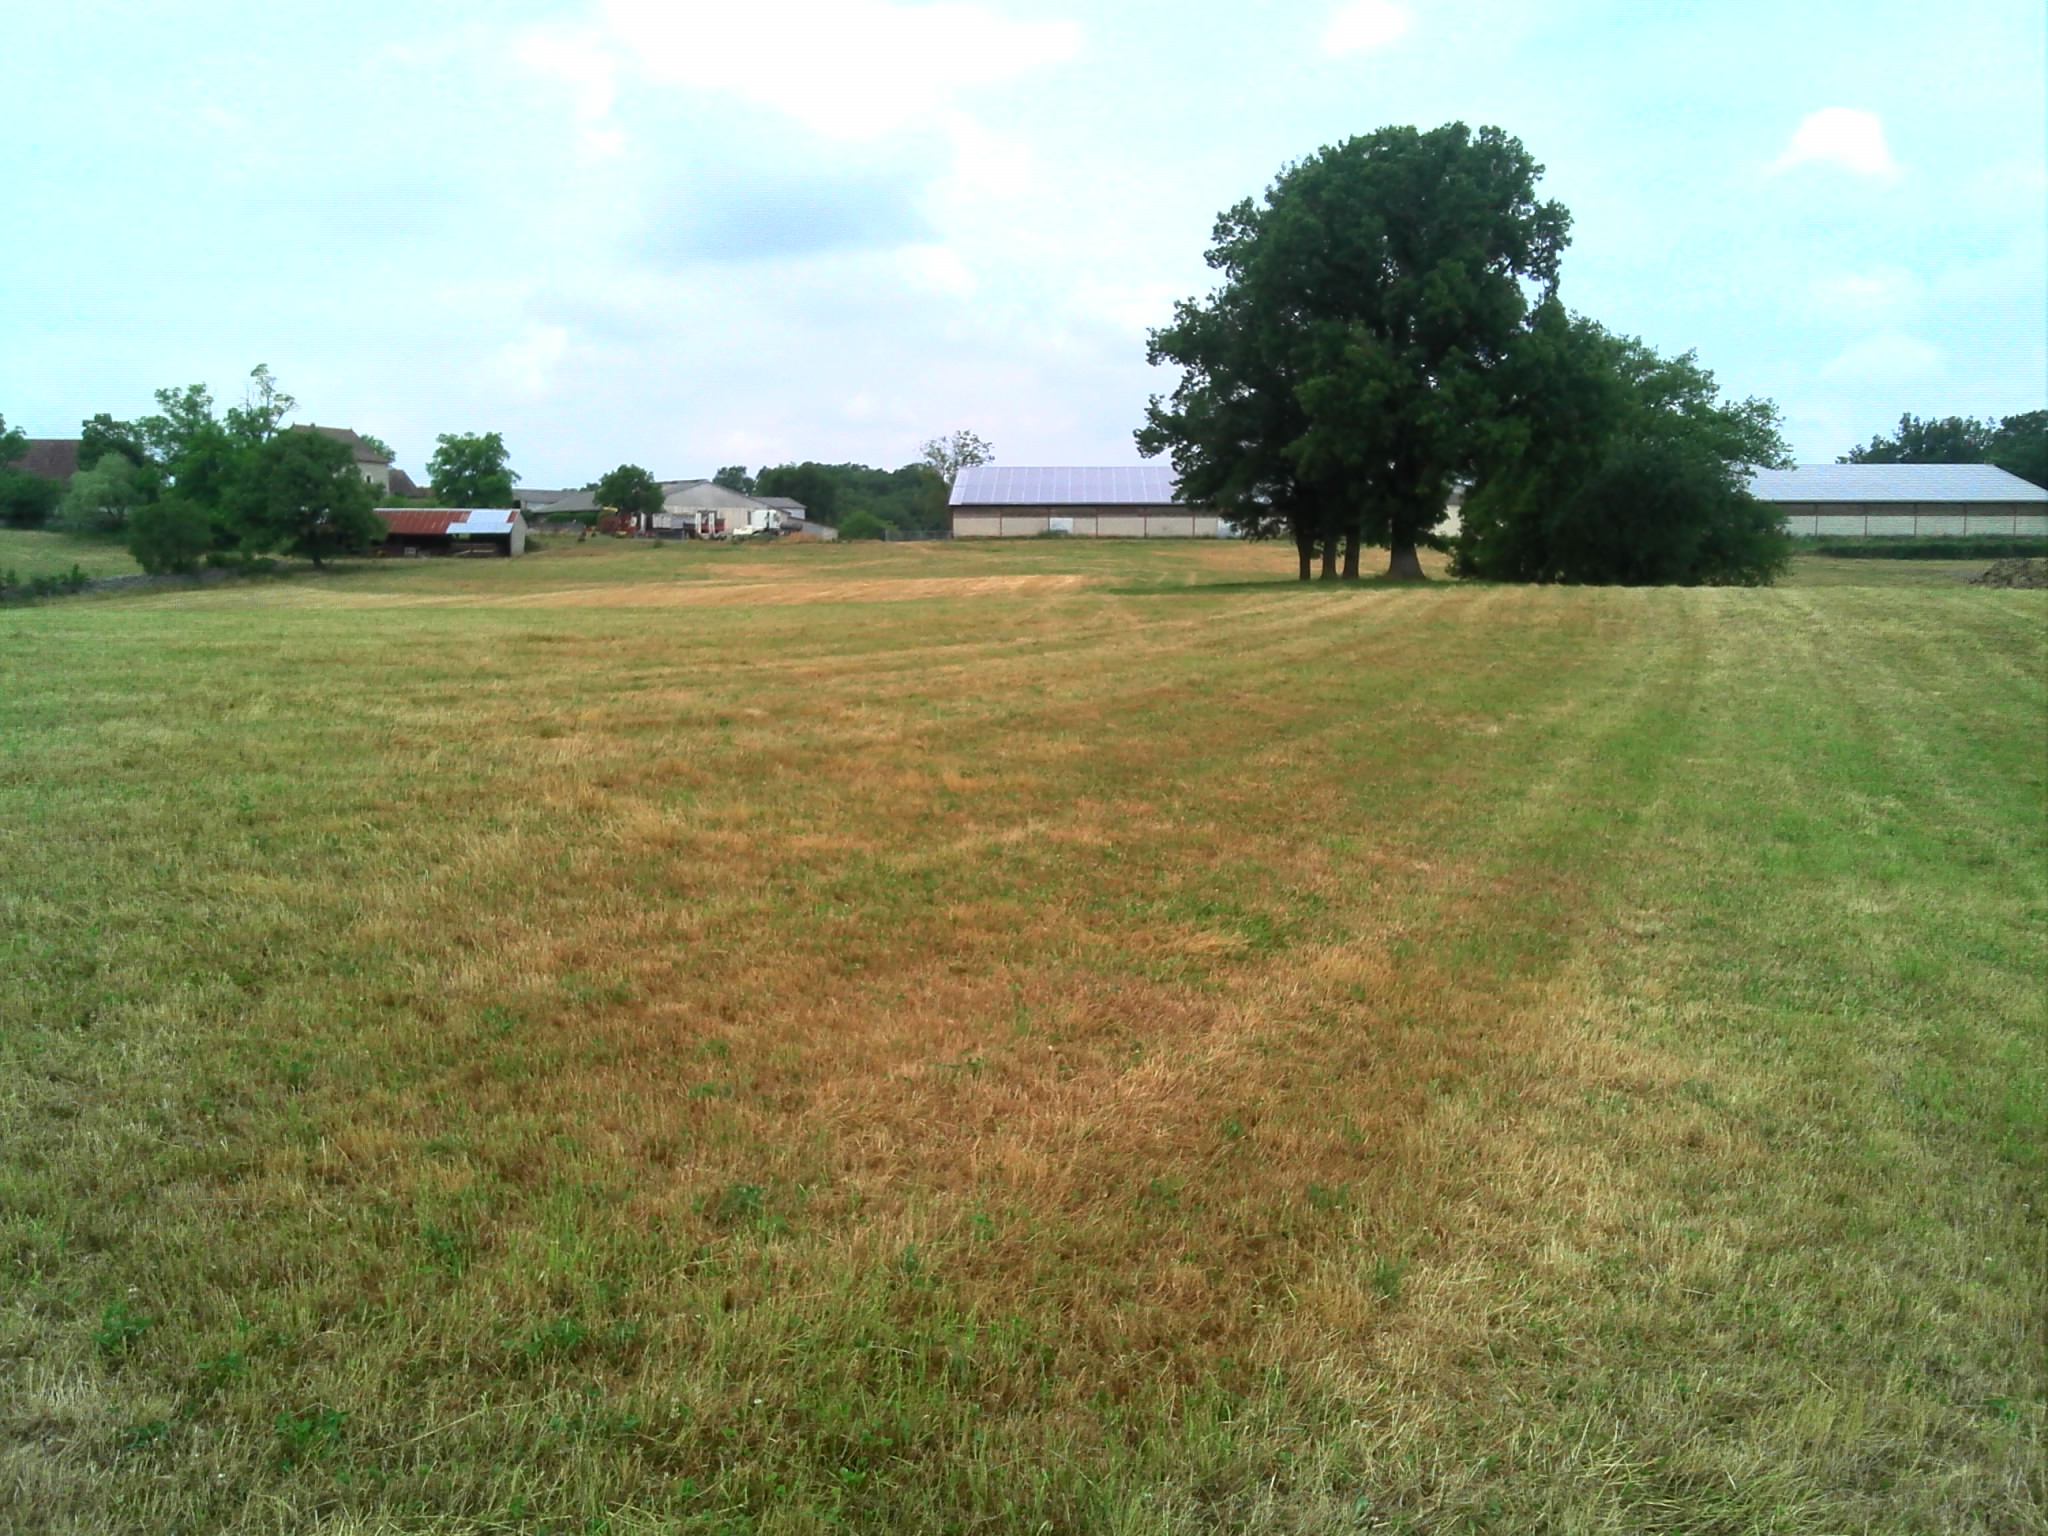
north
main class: Grassland
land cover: Grassland without tree/shrub cover
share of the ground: > 75 %
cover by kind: herbaceous plants 100 %
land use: Agriculture (excluding fallow land and kitchen gardens)
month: June
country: FR
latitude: 44.6967
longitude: 1.8088
